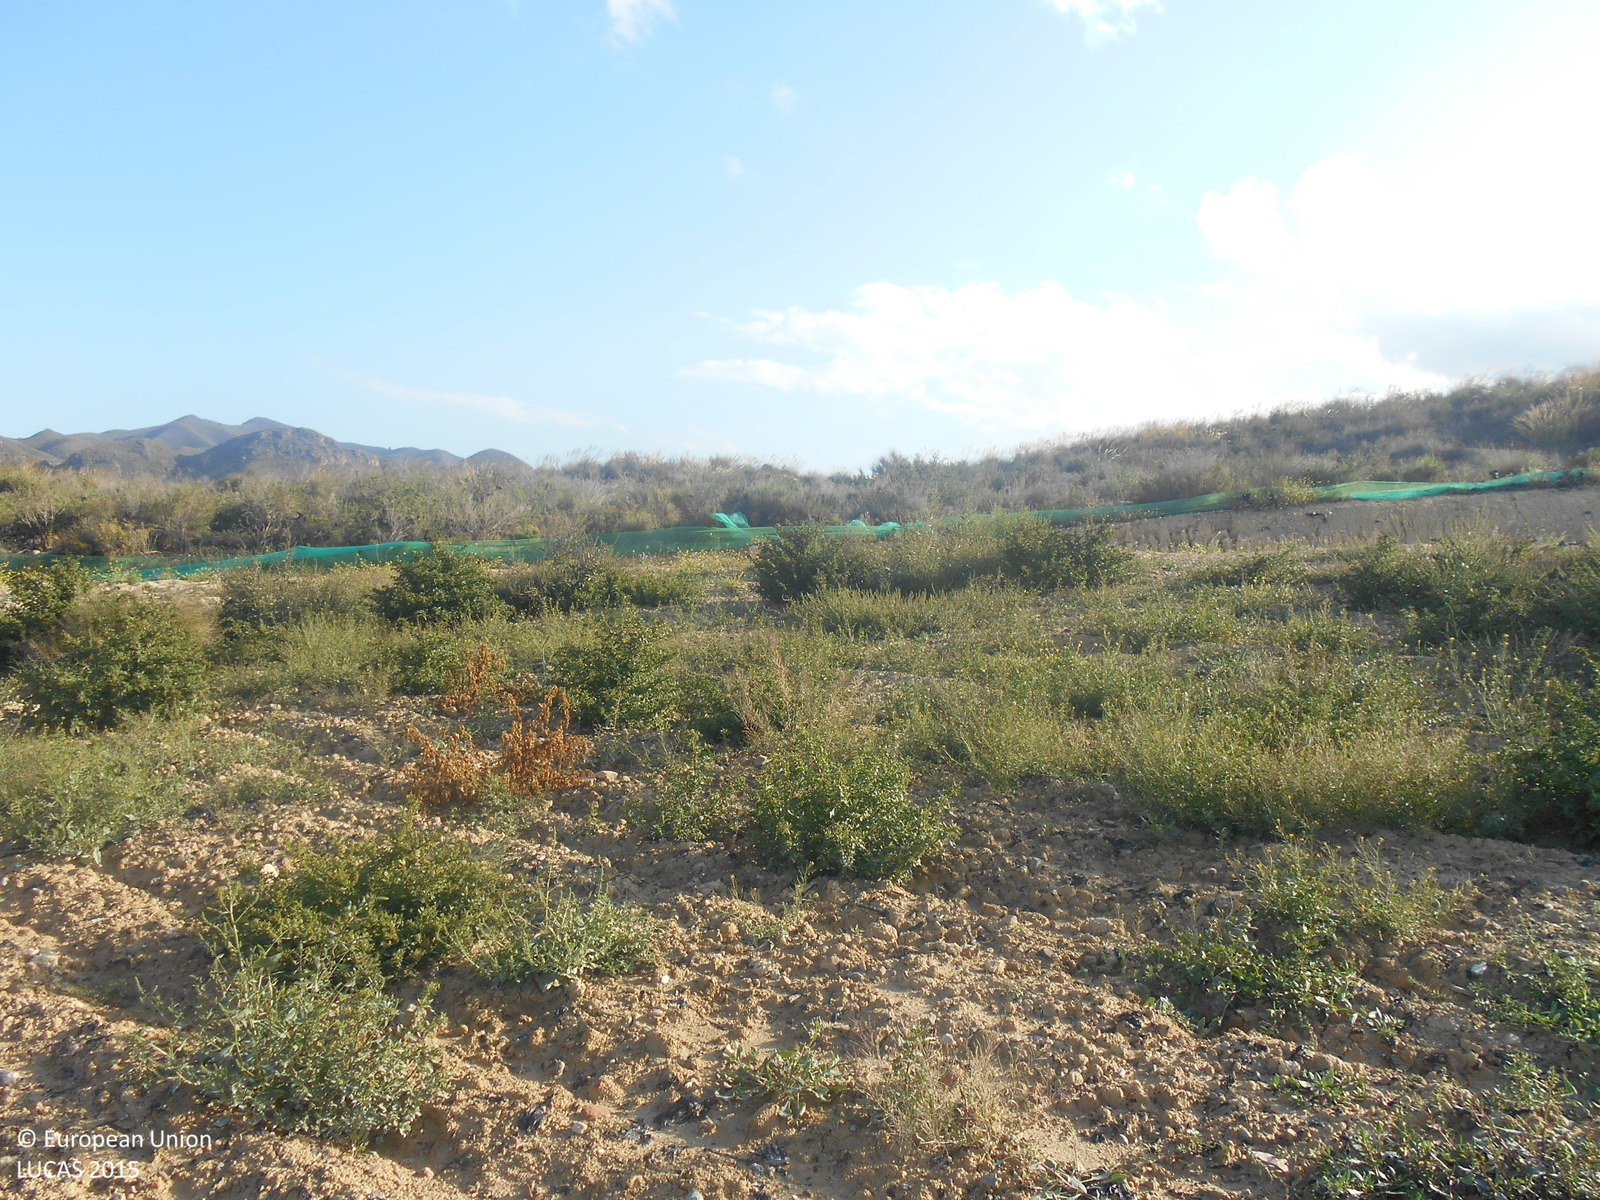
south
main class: Grassland
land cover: Spontaneously vegetated surfaces
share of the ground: > 75 %
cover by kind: herbaceous plants 80 %, unconsolidated bare surface 20 %
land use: Fallow land
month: April
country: ES
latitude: 37.6764
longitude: -1.4444
